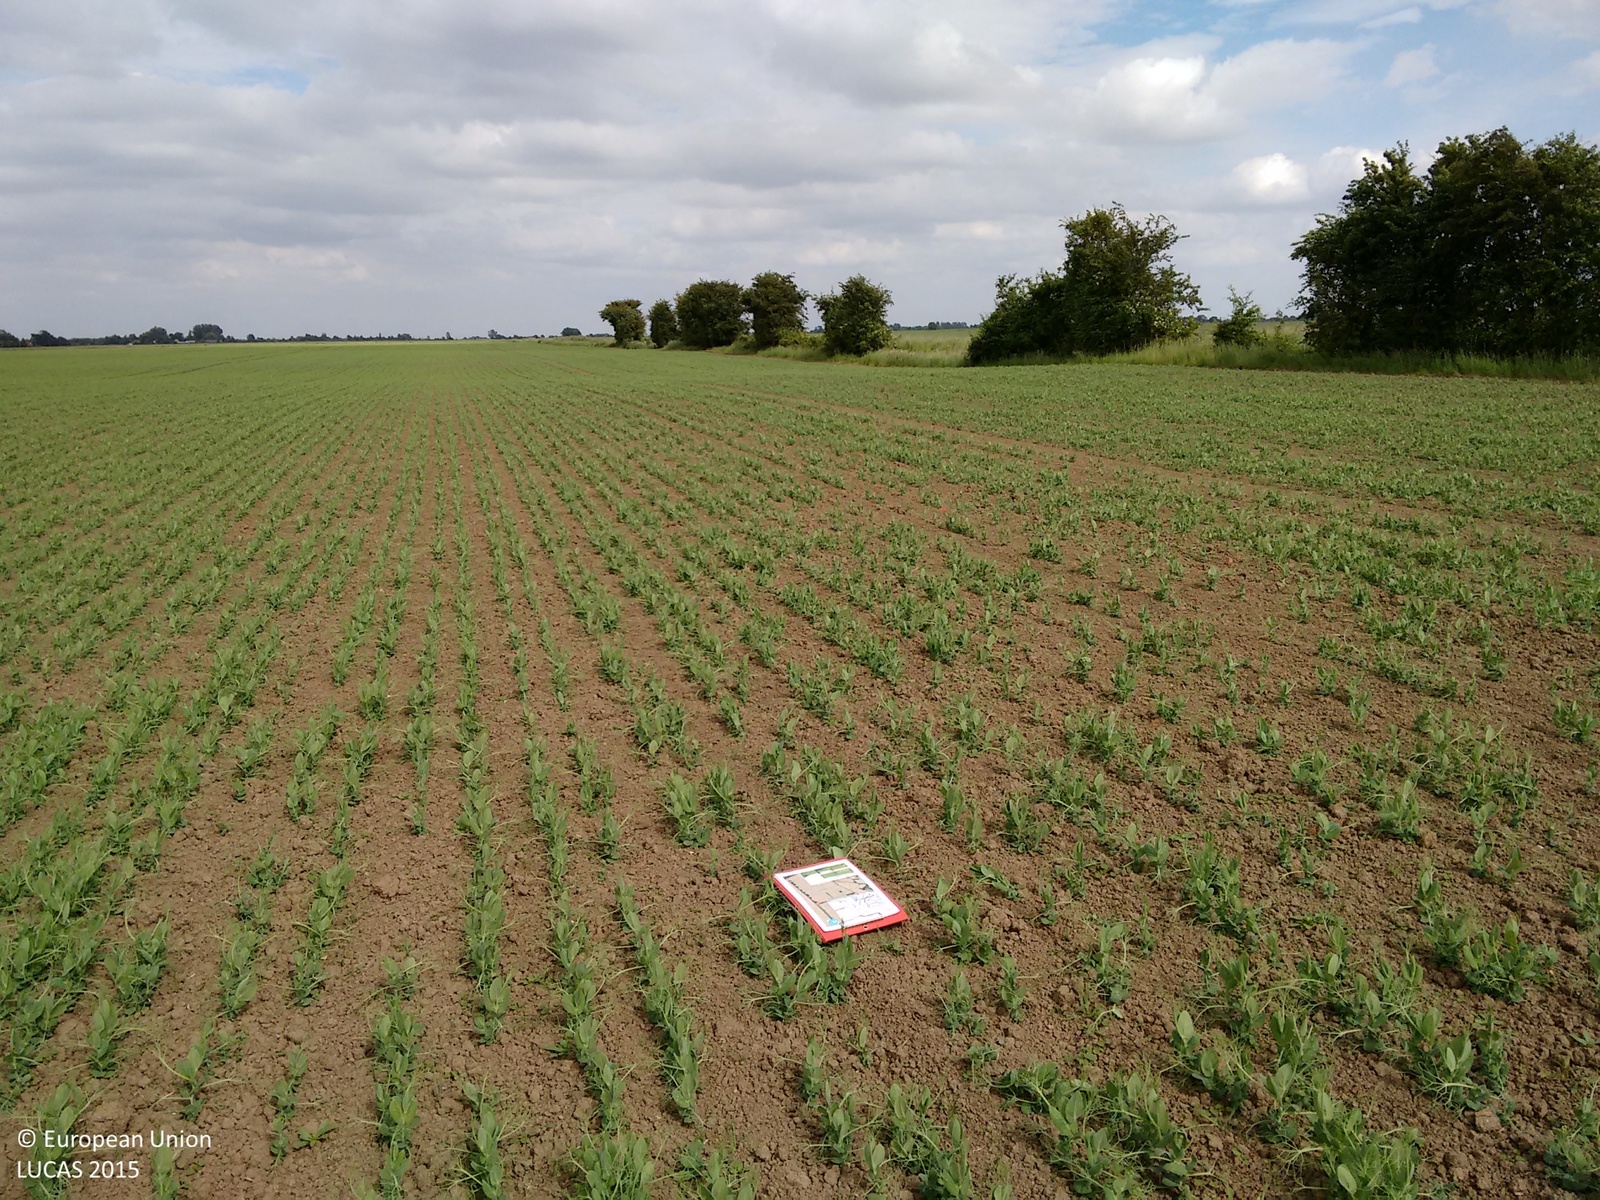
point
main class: Cropland
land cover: Dry pulses
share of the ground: 25 - 50 %
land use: Agriculture (excluding fallow land and kitchen gardens)
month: June
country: GB
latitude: 53.0178
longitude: -0.0651
